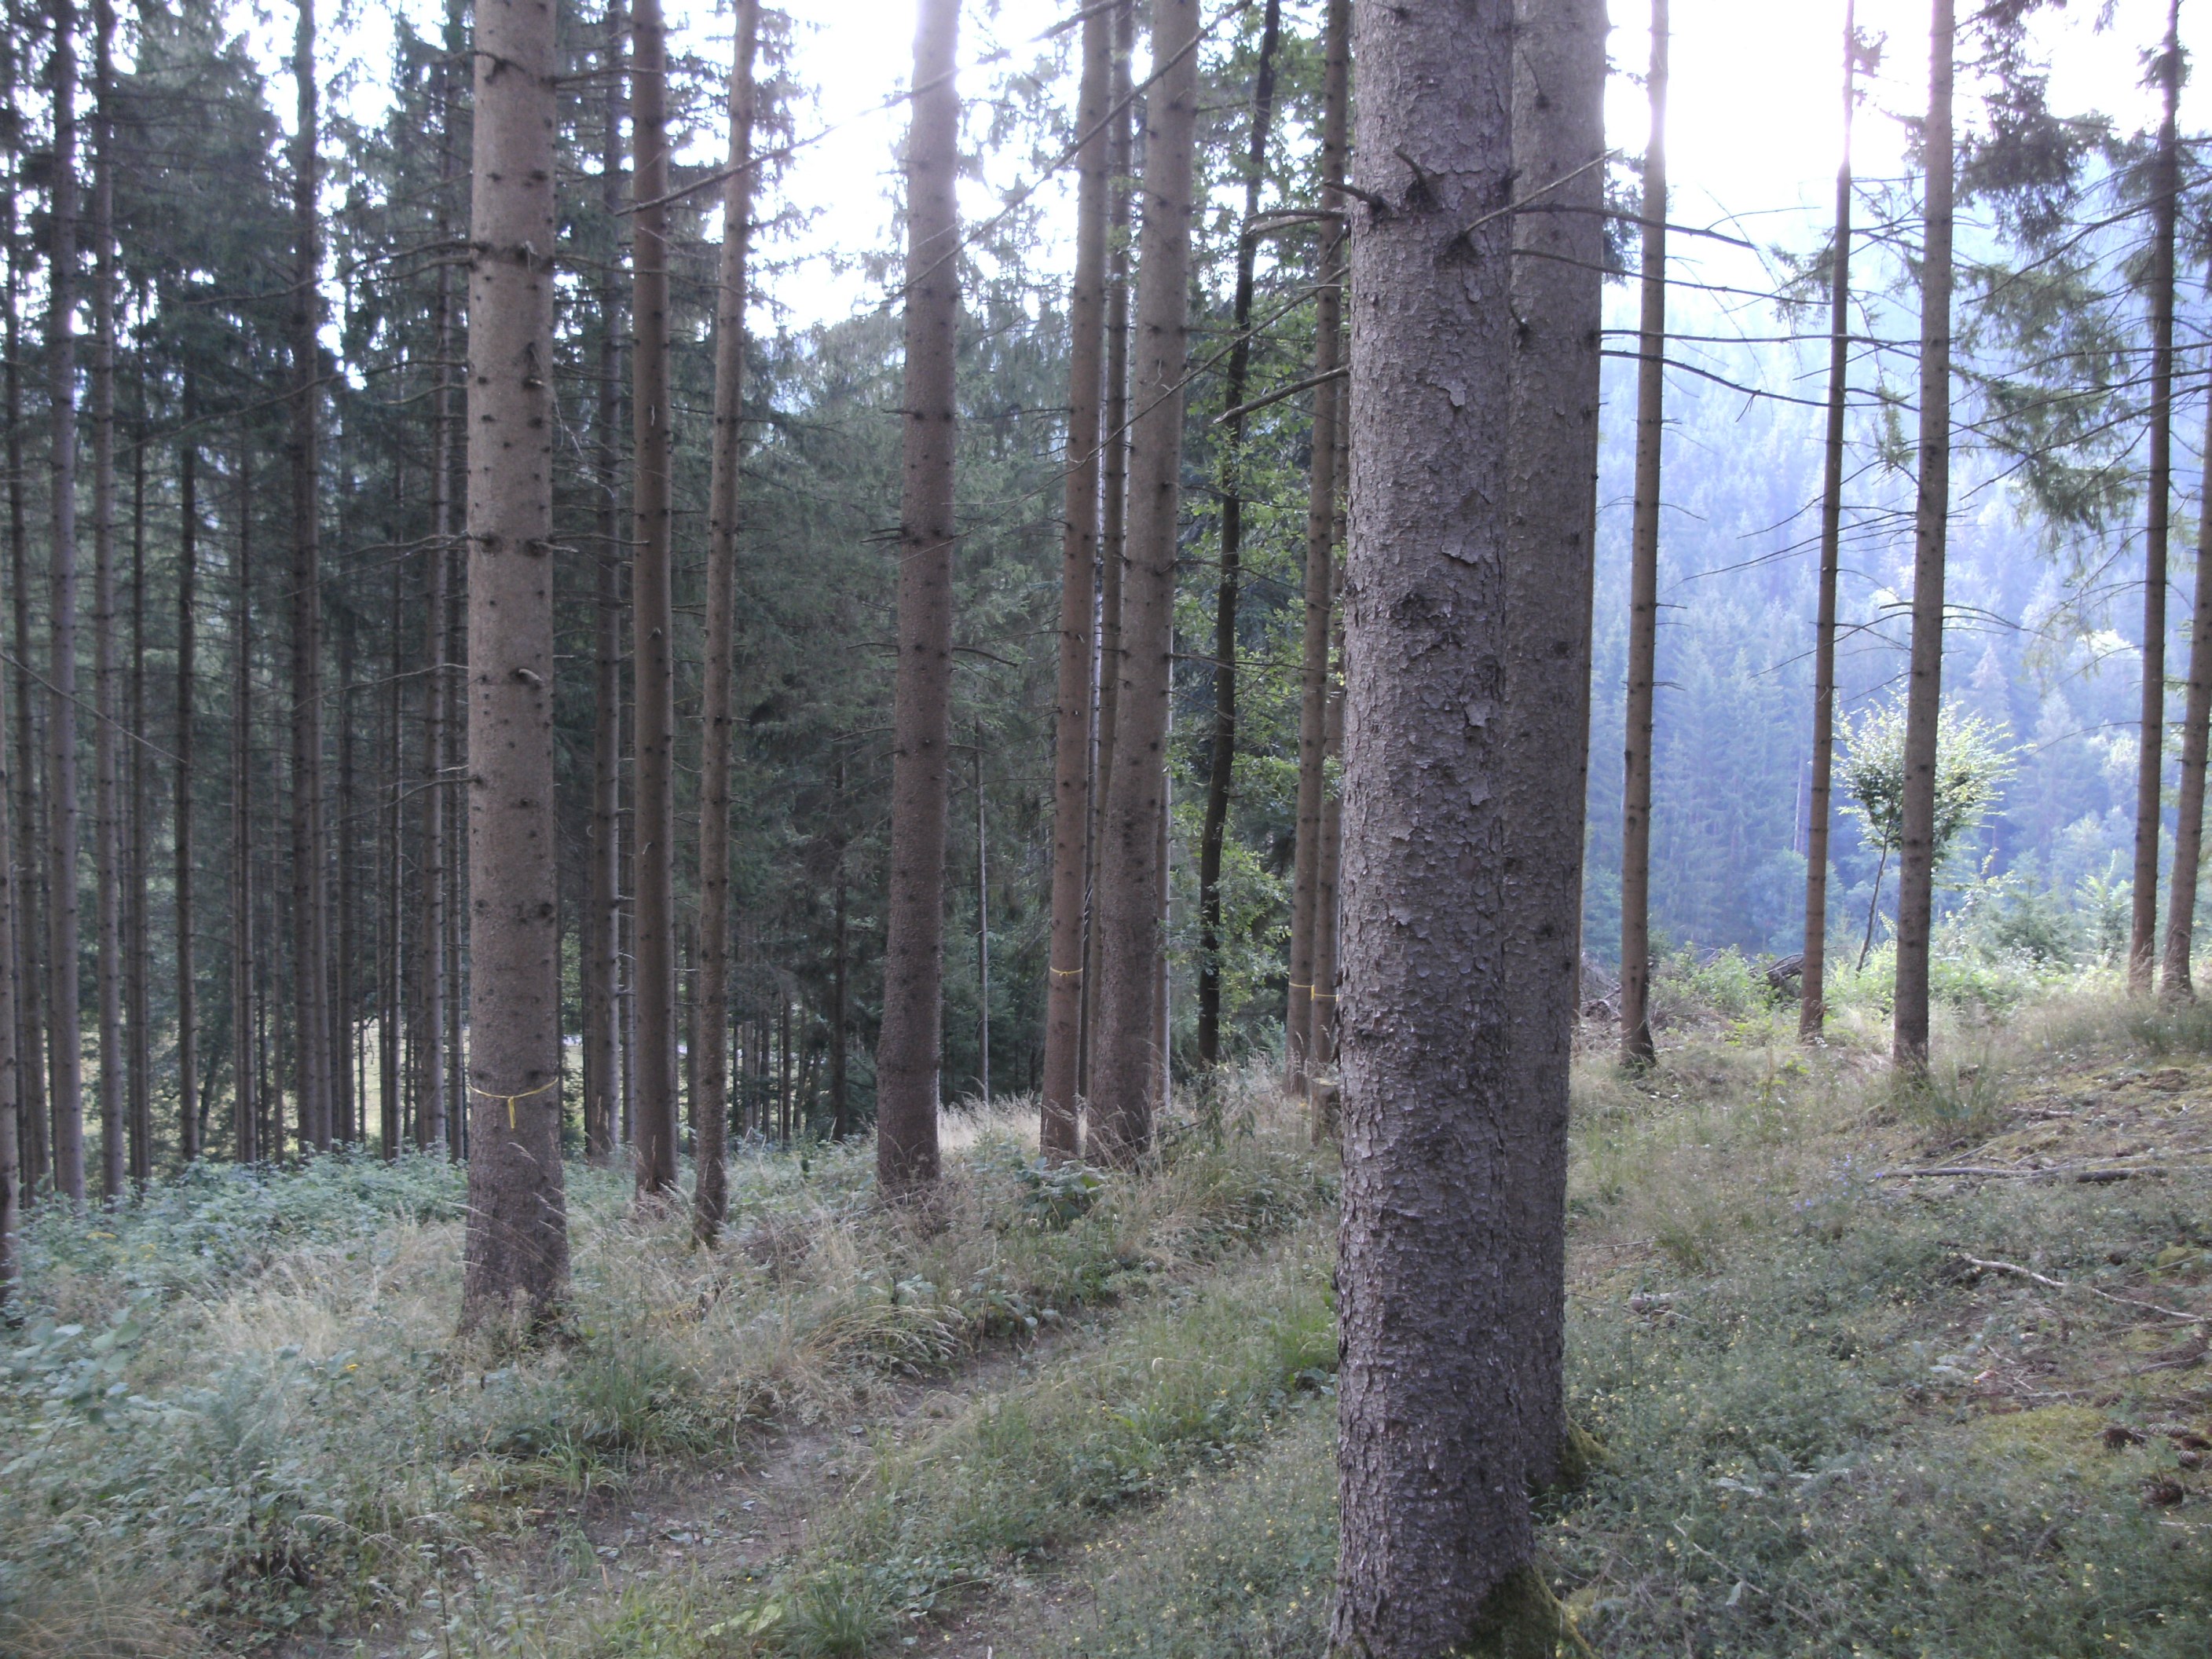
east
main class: Woodland
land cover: Spruce dominated coniferous woodland
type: hemiboreal forest and nemoral coniferous forest and mixed broadleaved-coniferous forest
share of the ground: > 75 %
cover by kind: coniferous forest trees 70 %, unconsolidated bare surface 10 %, broadleaved forest trees 5 %, shrubs 5 %, herbaceous plants 5 %, lichens and mosses 5 %
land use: Forestry
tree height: > 5 m
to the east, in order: Spruce dominated coniferous woodland; Tracks; Spruce dominated coniferous woodland; Tracks; Spruce dominated coniferous woodland; Ditches and canals; Broadleaved woodland; Grassland with sparse tree/shrub cover; Paved roads, cycling and walking lanes; Grass margins; Spruce dominated coniferous woodland; Rivers and streams; Spruce dominated coniferous woodland; Tracks; Spruce dominated coniferous woodland
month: July
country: AT
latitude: 46.7114
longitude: 14.8250
